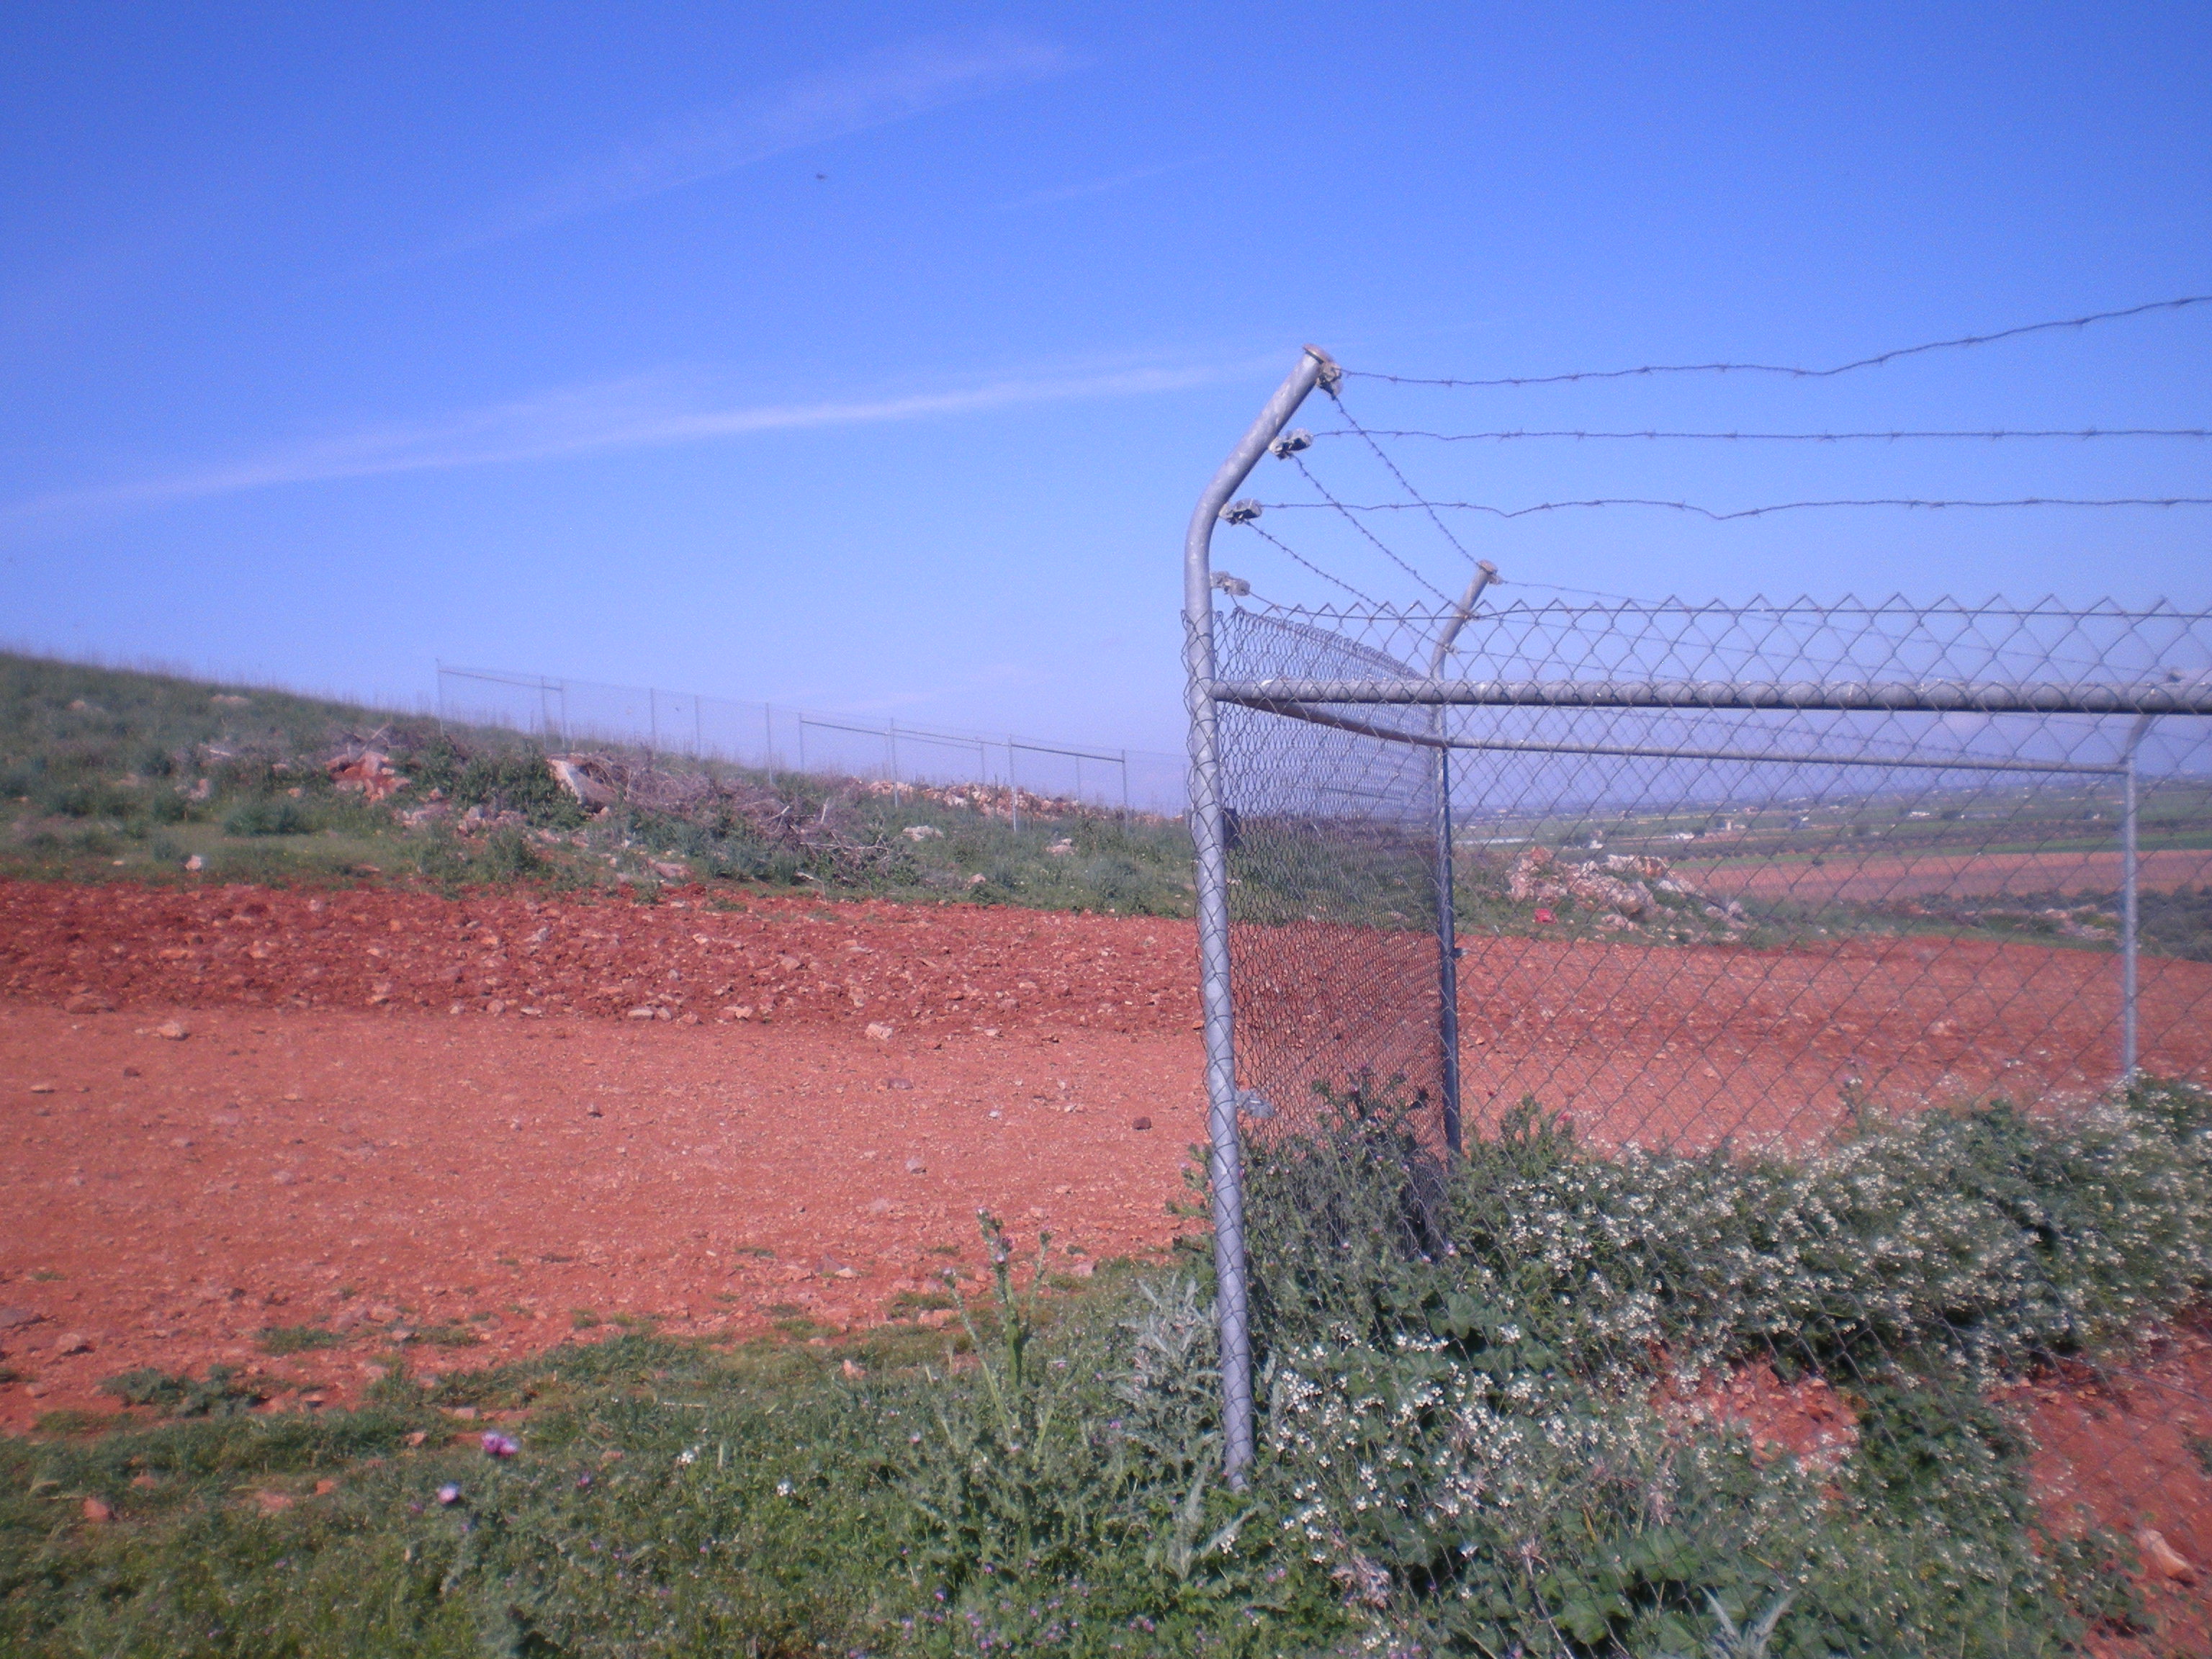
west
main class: Grassland
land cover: Grassland without tree/shrub cover
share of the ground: > 75 %
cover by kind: herbaceous plants 80 %, unconsolidated bare surface 20 %
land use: Agriculture (excluding fallow land and kitchen gardens)
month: April
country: ES
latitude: 38.9170
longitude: -3.5668
